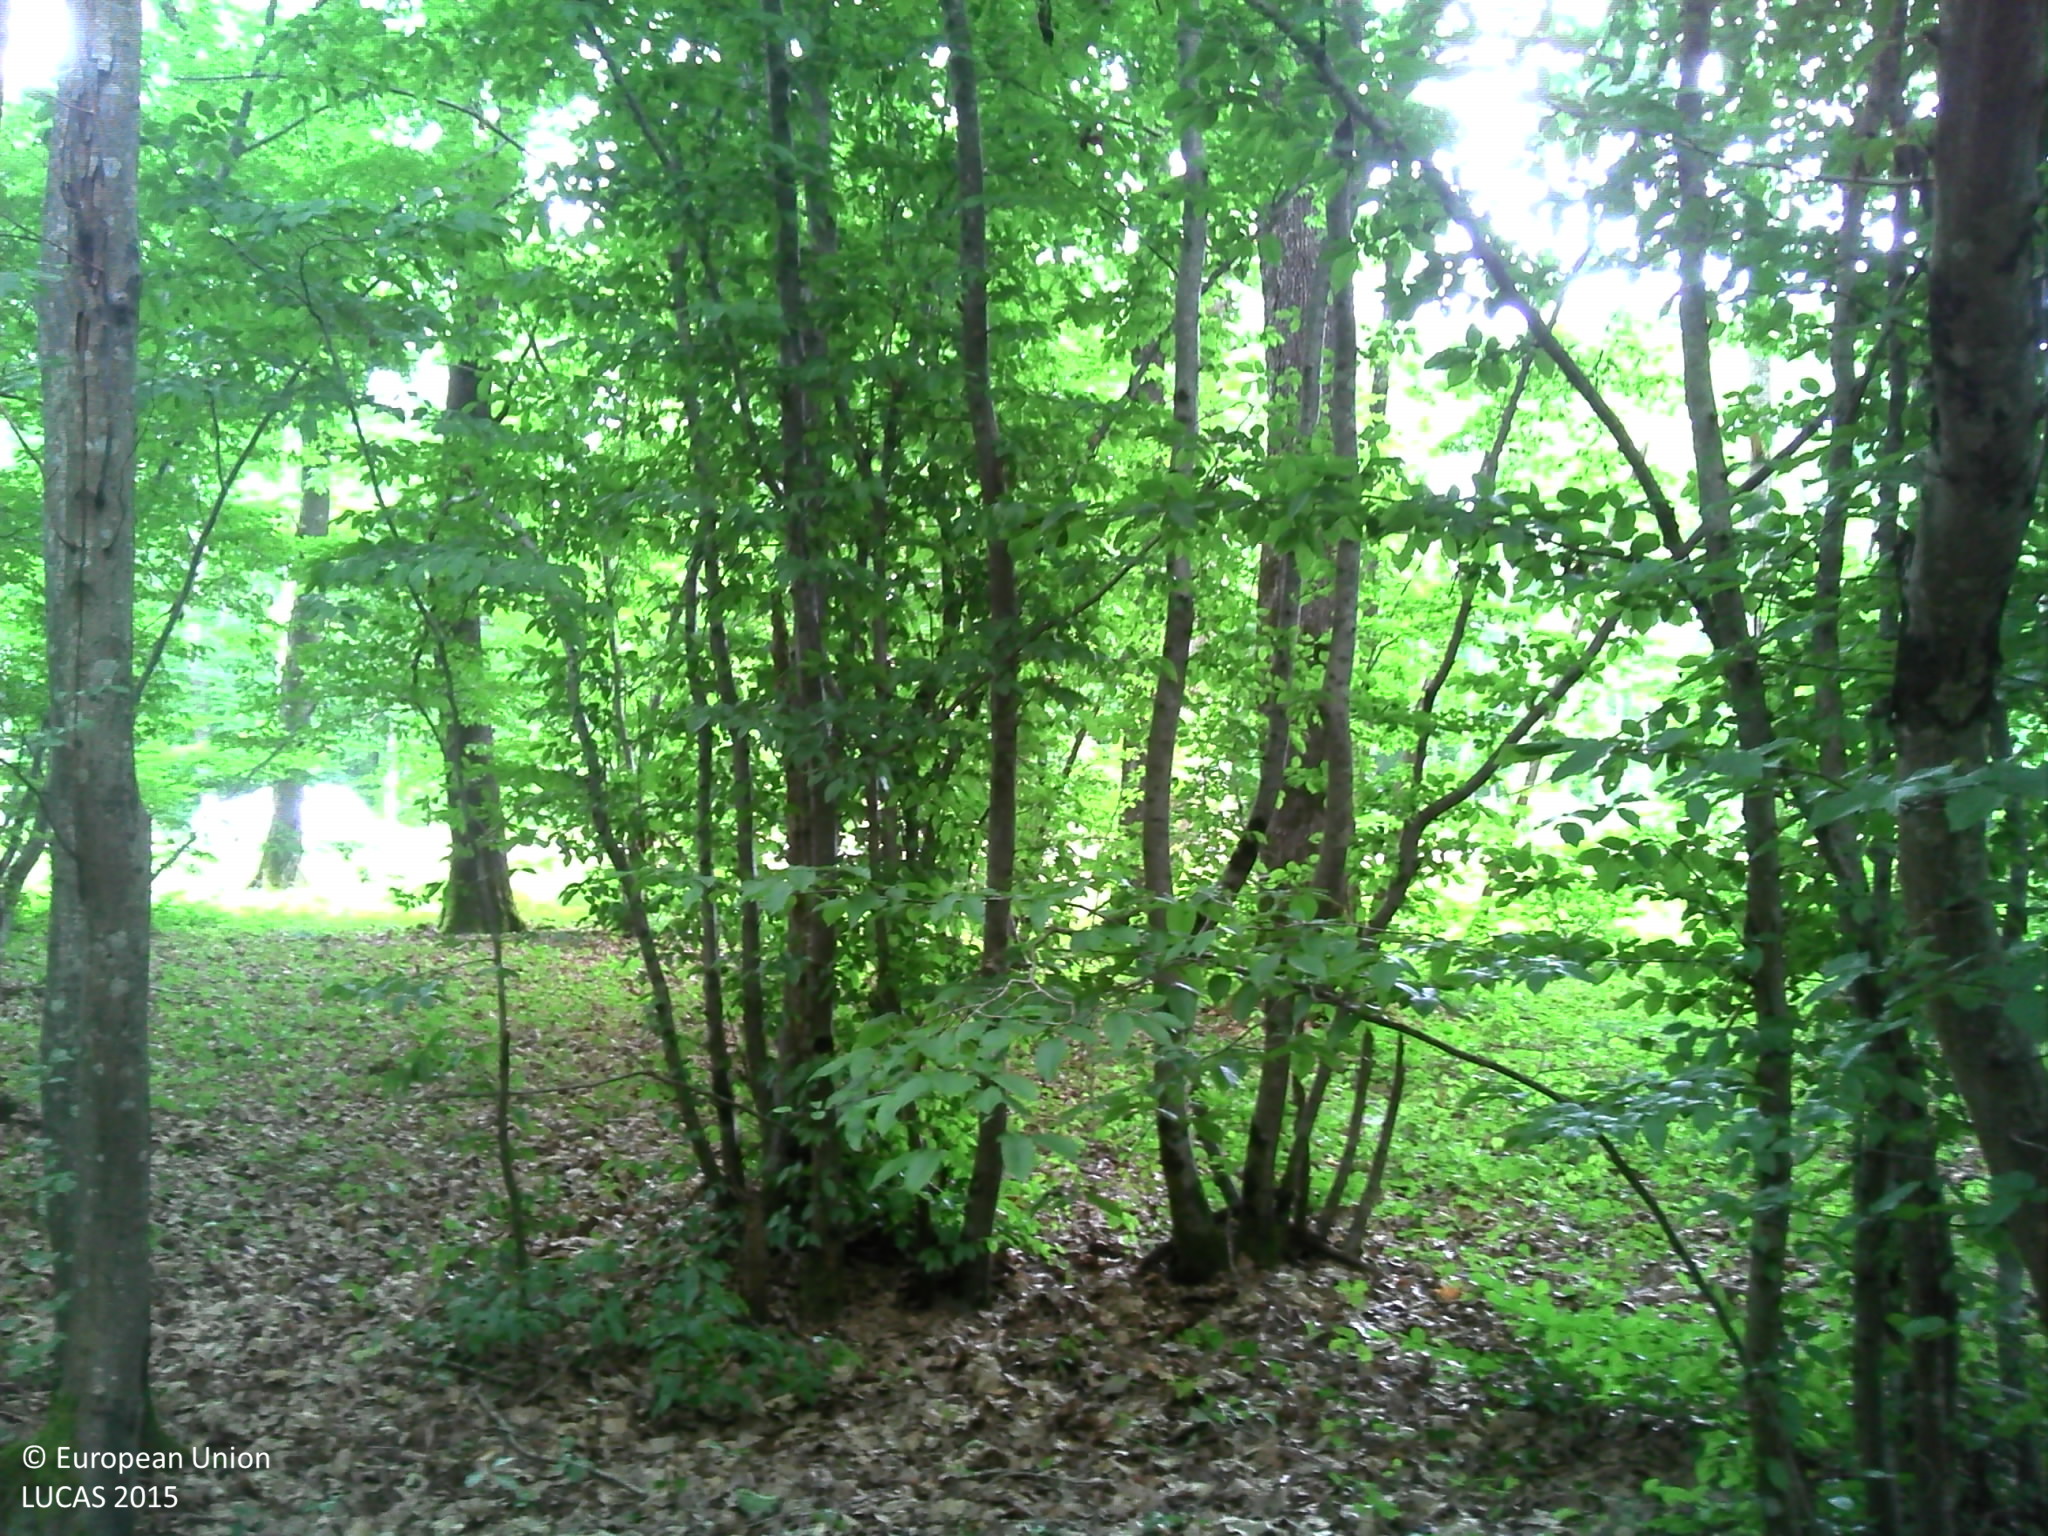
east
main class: Woodland
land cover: Broadleaved woodland
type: mesophytic deciduous forest
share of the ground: > 75 %
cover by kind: broadleaved forest trees 90 %, herbaceous plants 10 %
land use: Forestry
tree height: > 5 m
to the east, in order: Broadleaved woodland; Grassland without tree/shrub cover; Ditches and canals; Paved roads, cycling and walking lanes; Ditches and canals; Electric lines; Spontaneously vegetated surfaces; Broadleaved woodland; Grassland with sparse tree/shrub cover; Shrubland without tree cover; Electric lines; Broadleaved woodland; Grassland without tree/shrub cover; Fences; Grassland without tree/shrub cover; Paved roads, cycling and walking lanes; Grassland without tree/shrub cover; Fences; Grassland without tree/shrub cover; Broadleaved woodland
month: July
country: FR
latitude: 46.1268
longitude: 3.3602
